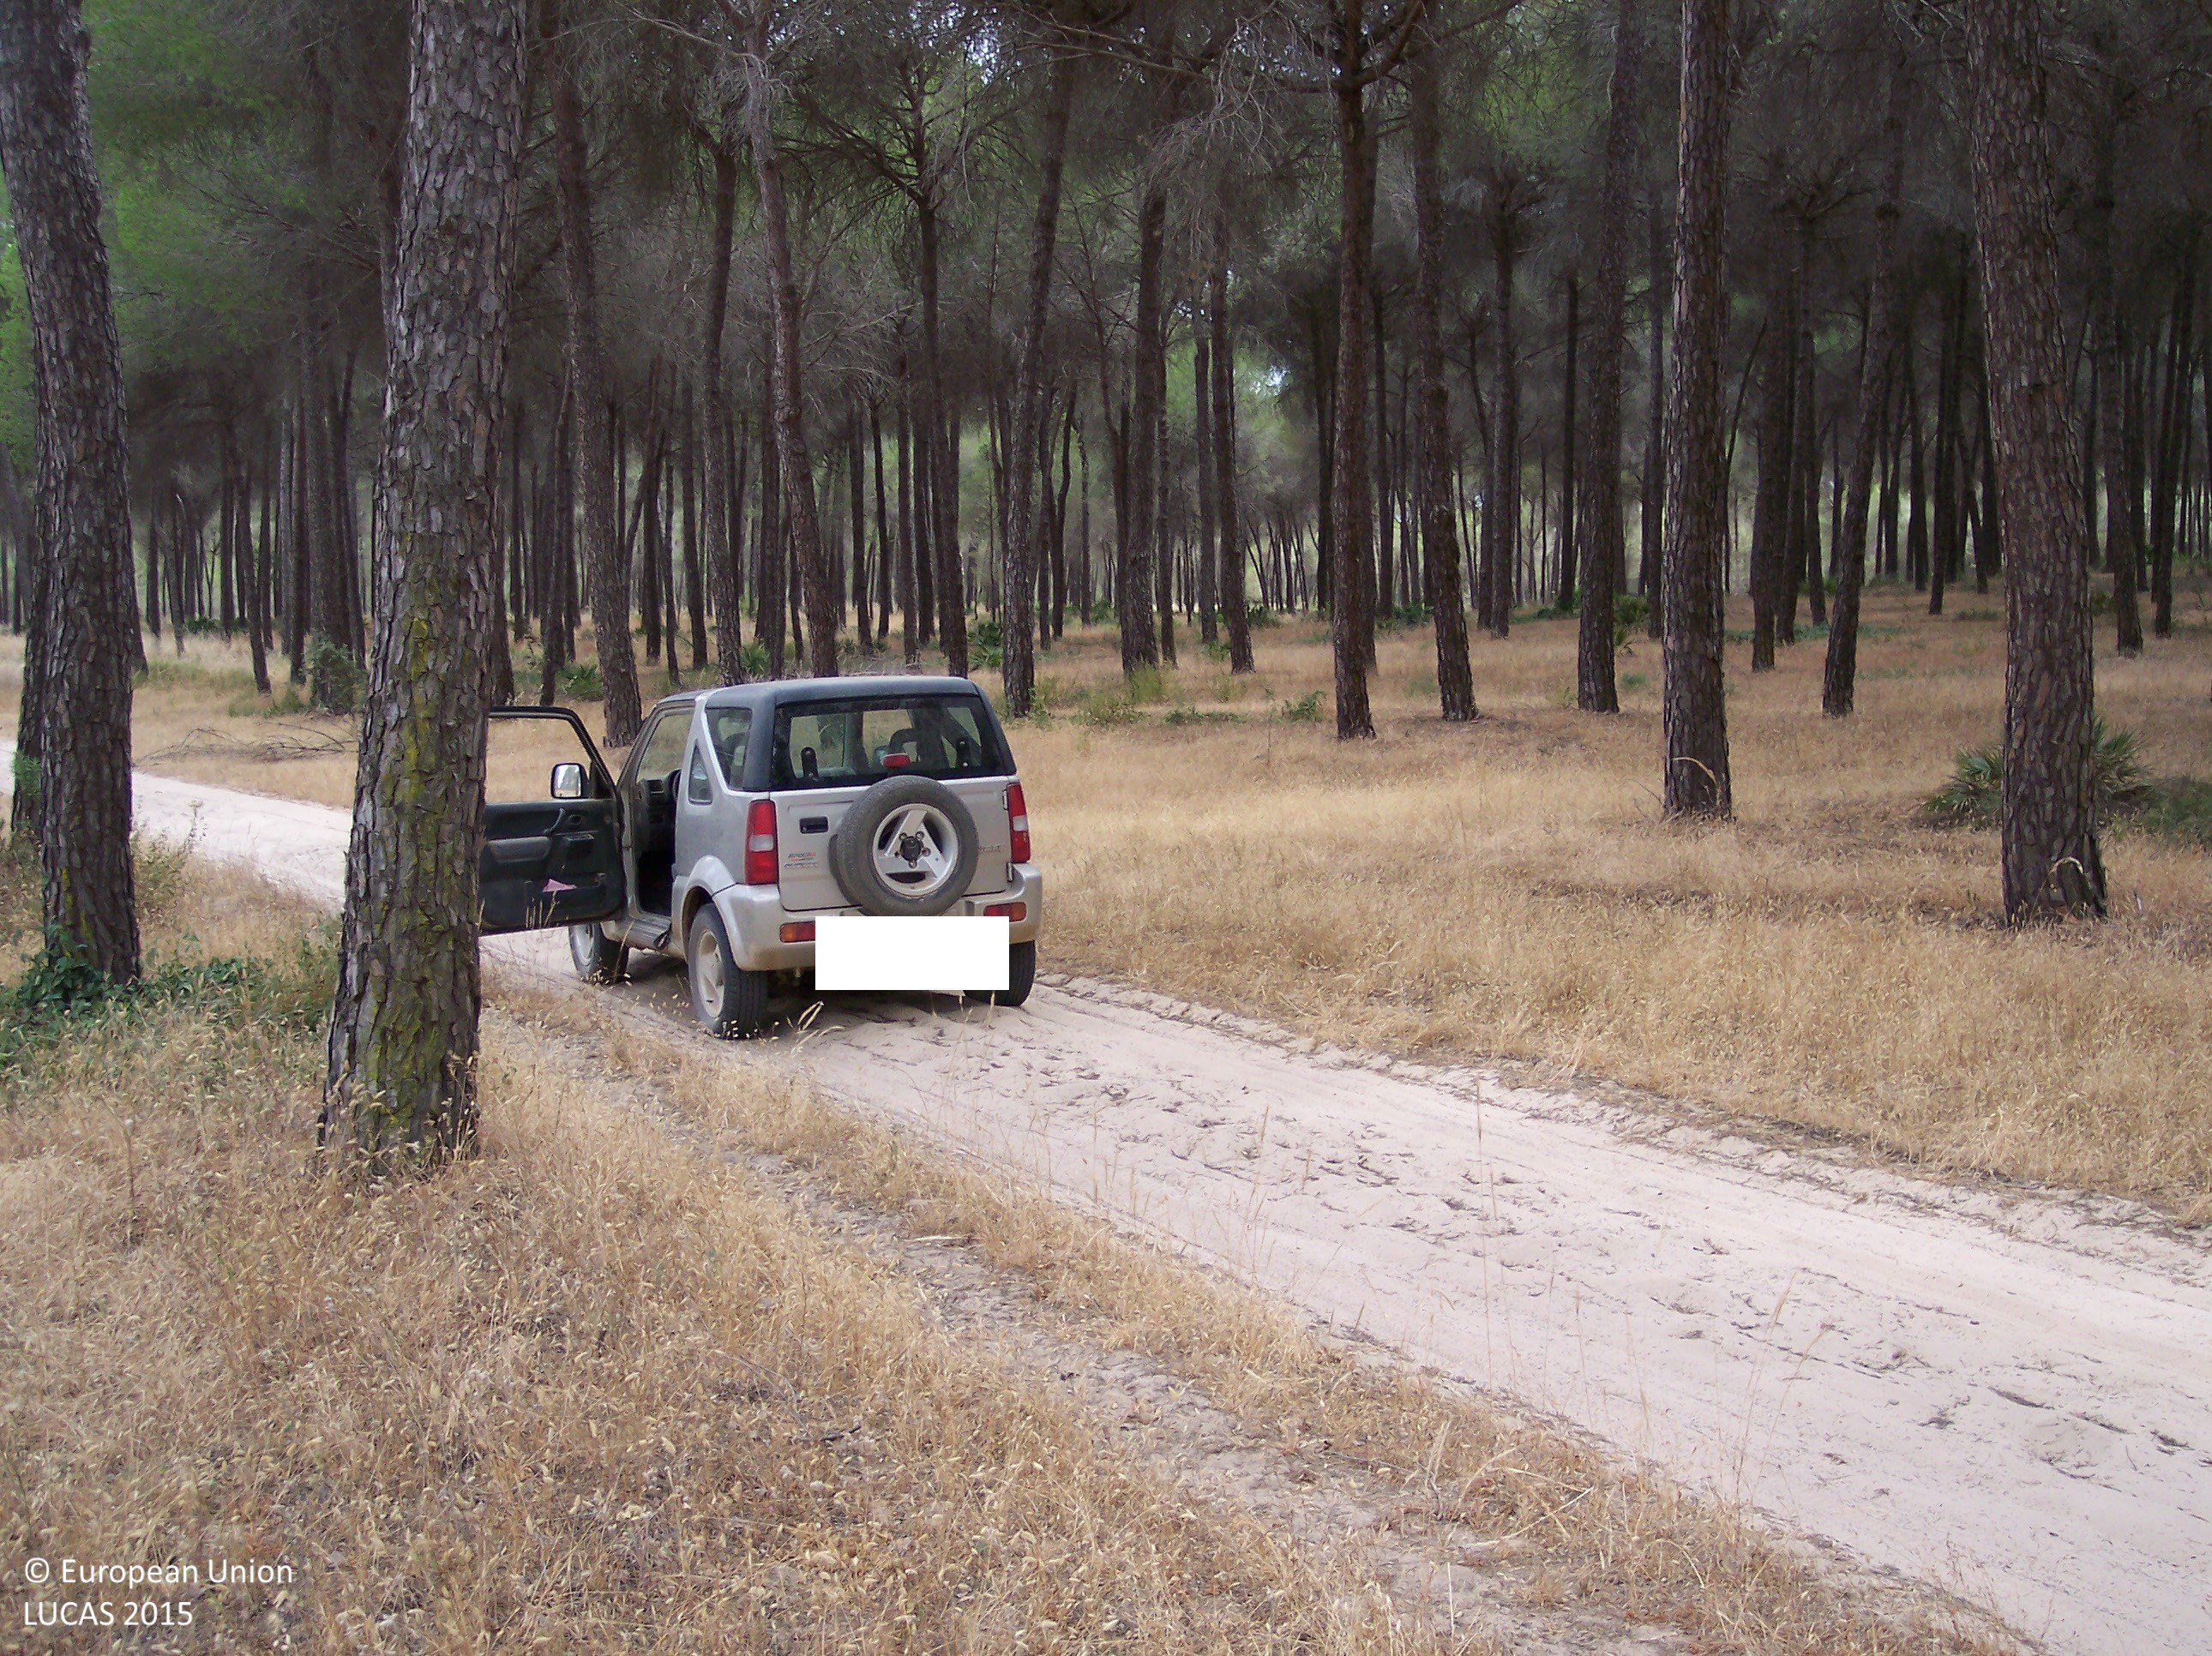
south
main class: Woodland
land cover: Pine dominated coniferous woodland
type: coniferous forest of the mediterranean region
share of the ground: 50 - 75 %
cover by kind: coniferous forest trees 60 %, herbaceous plants 20 %, shrubs 10 %, unconsolidated bare surface 10 %
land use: Forestry
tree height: > 5 m
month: June
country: ES
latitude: 37.2919
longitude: -6.3964
